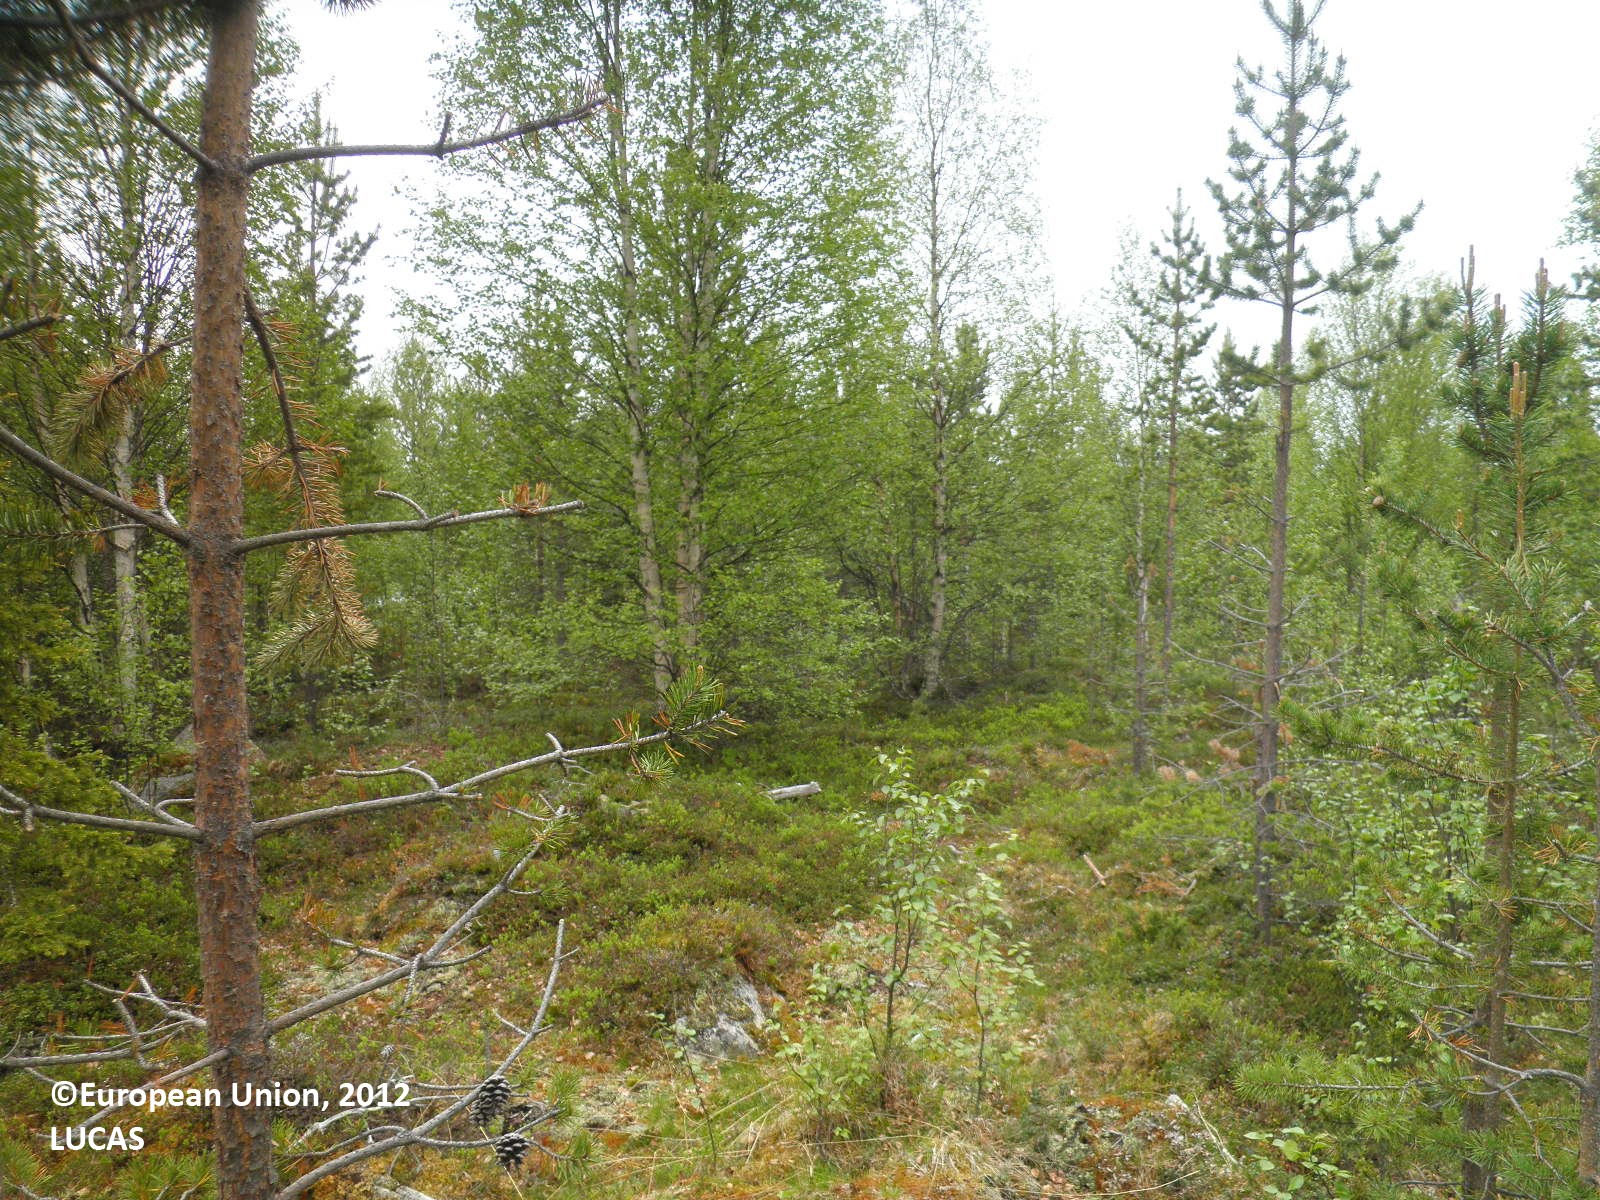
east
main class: Woodland
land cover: Pine dominated mixed woodland
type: boreal forest
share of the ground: 25 - 50 %
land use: Forestry
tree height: < 5 m
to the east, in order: Pine dominated mixed woodland; Tracks; Pine dominated mixed woodland
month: June
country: FI
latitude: 67.8407
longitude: 25.6557
